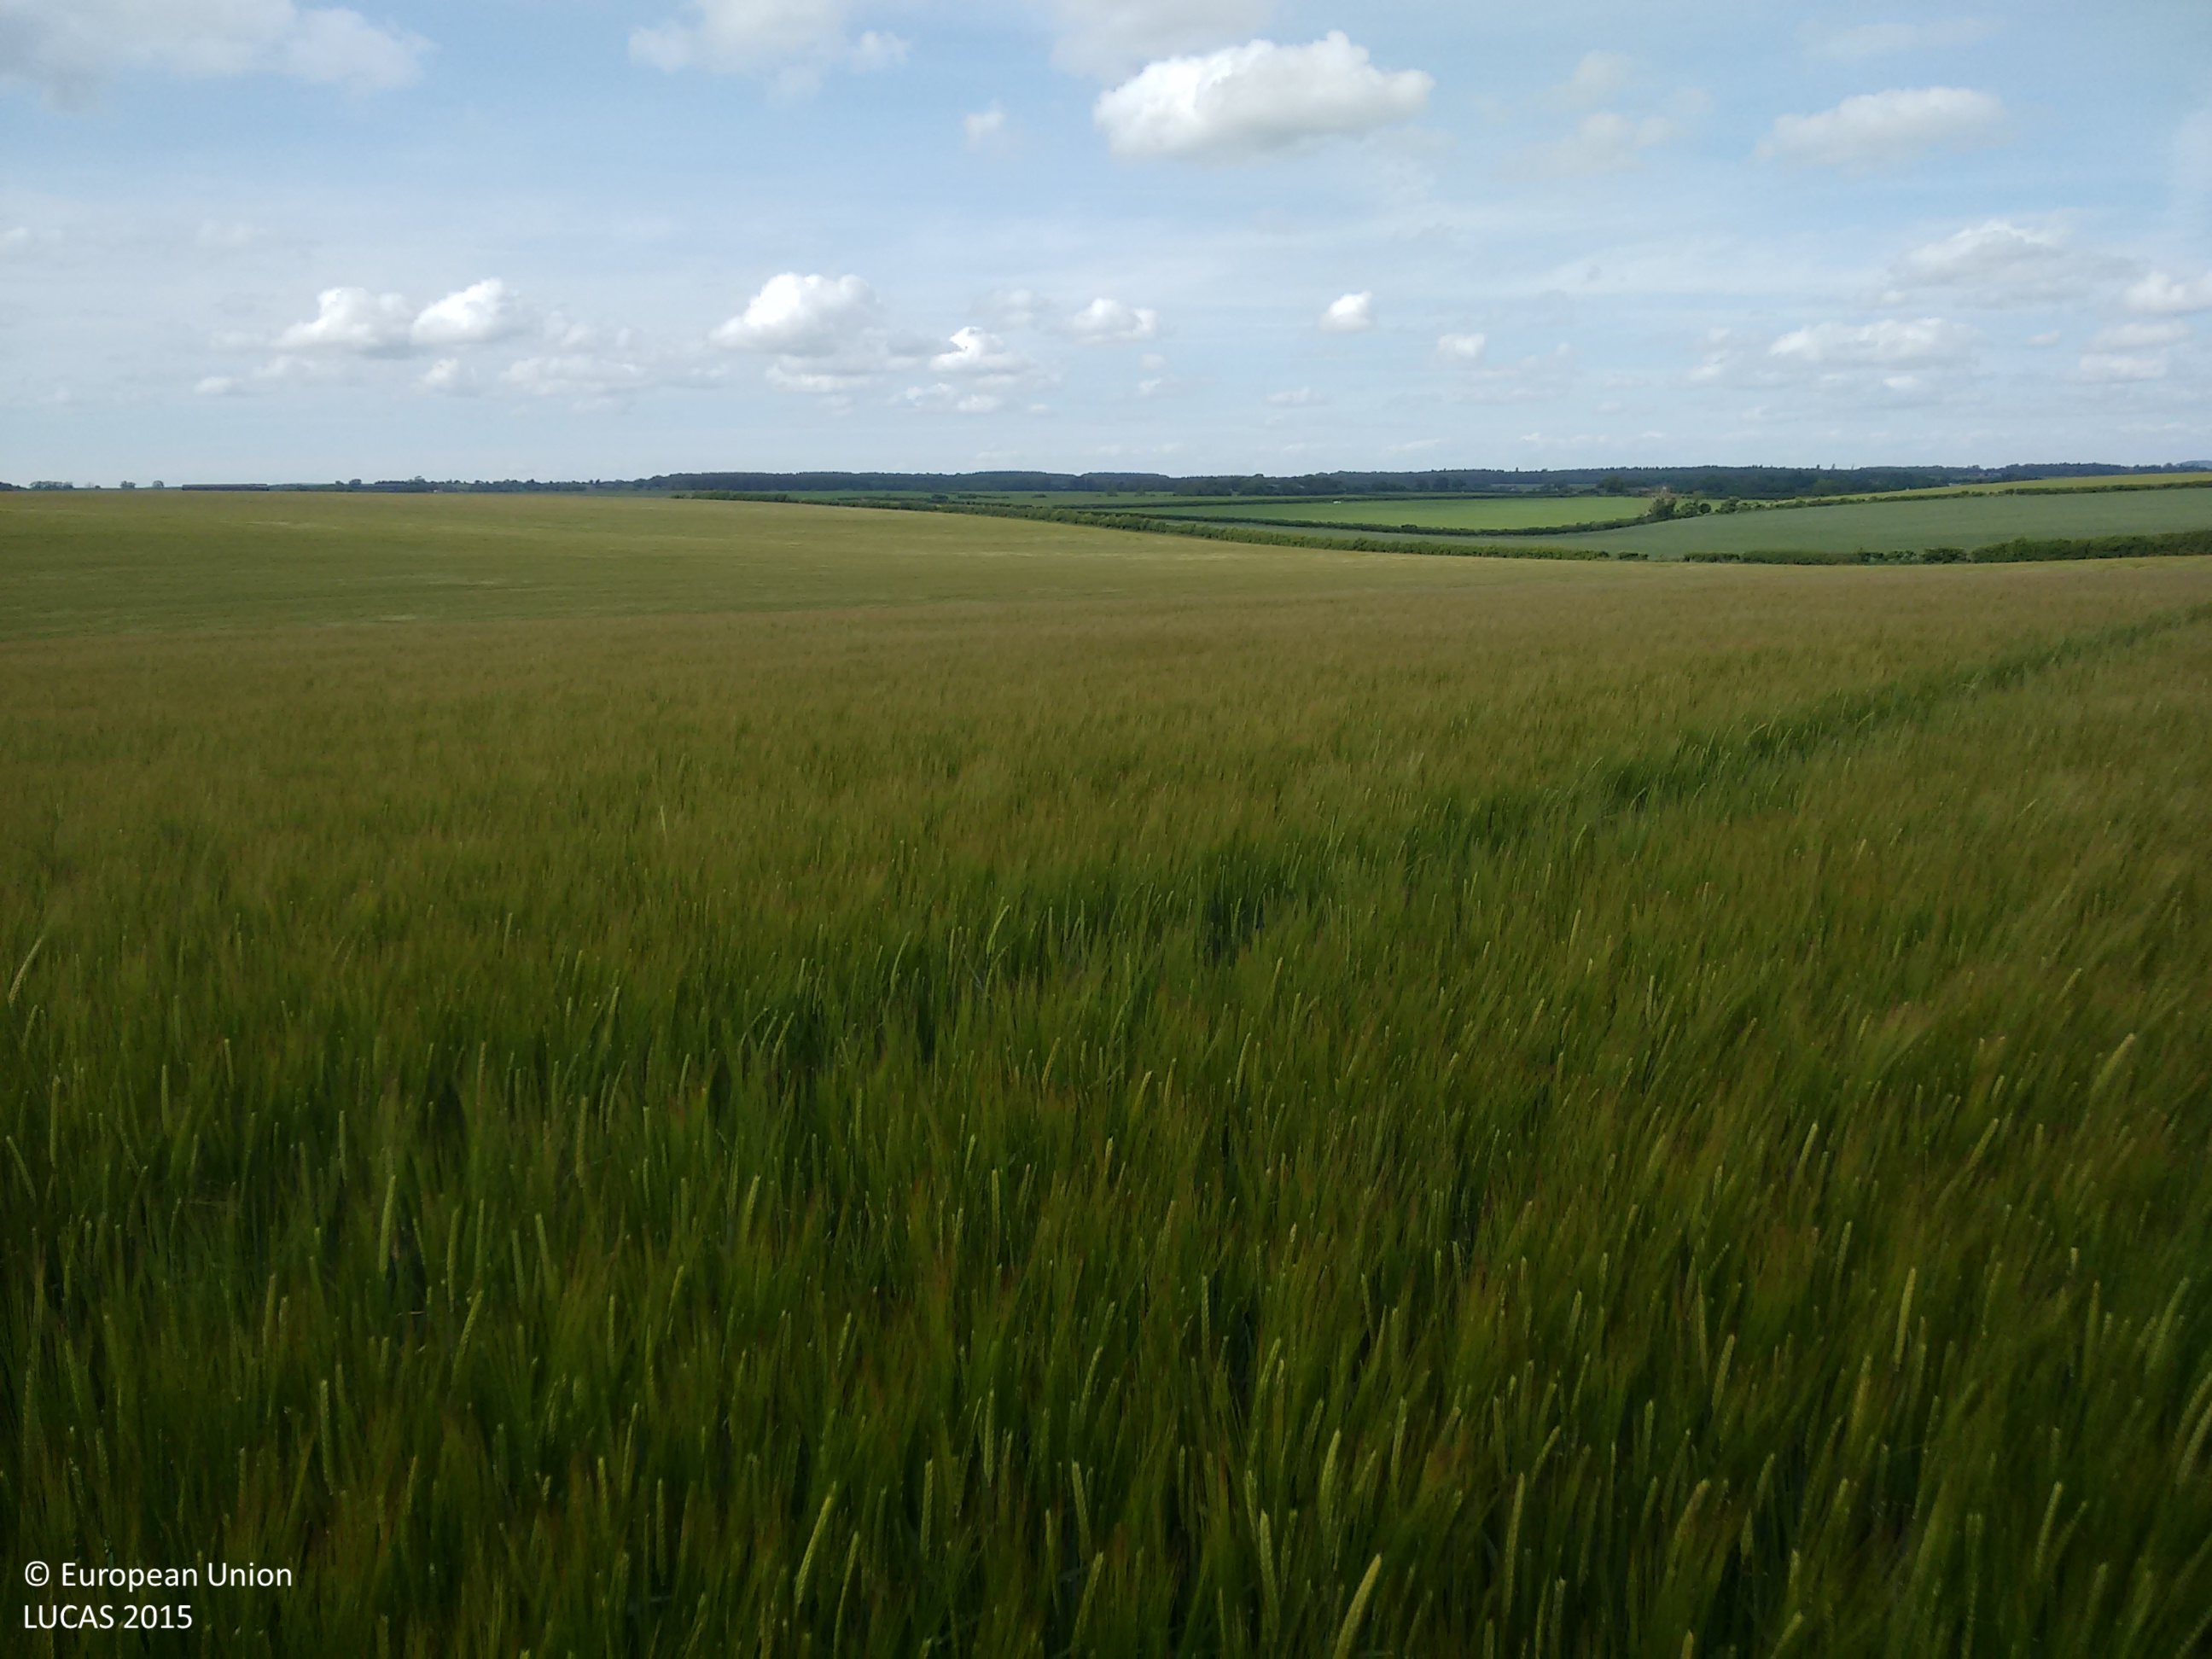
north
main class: Cropland
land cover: Barley
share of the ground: > 75 %
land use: Agriculture (excluding fallow land and kitchen gardens)
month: May
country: GB
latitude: 50.8328
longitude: -2.0569
